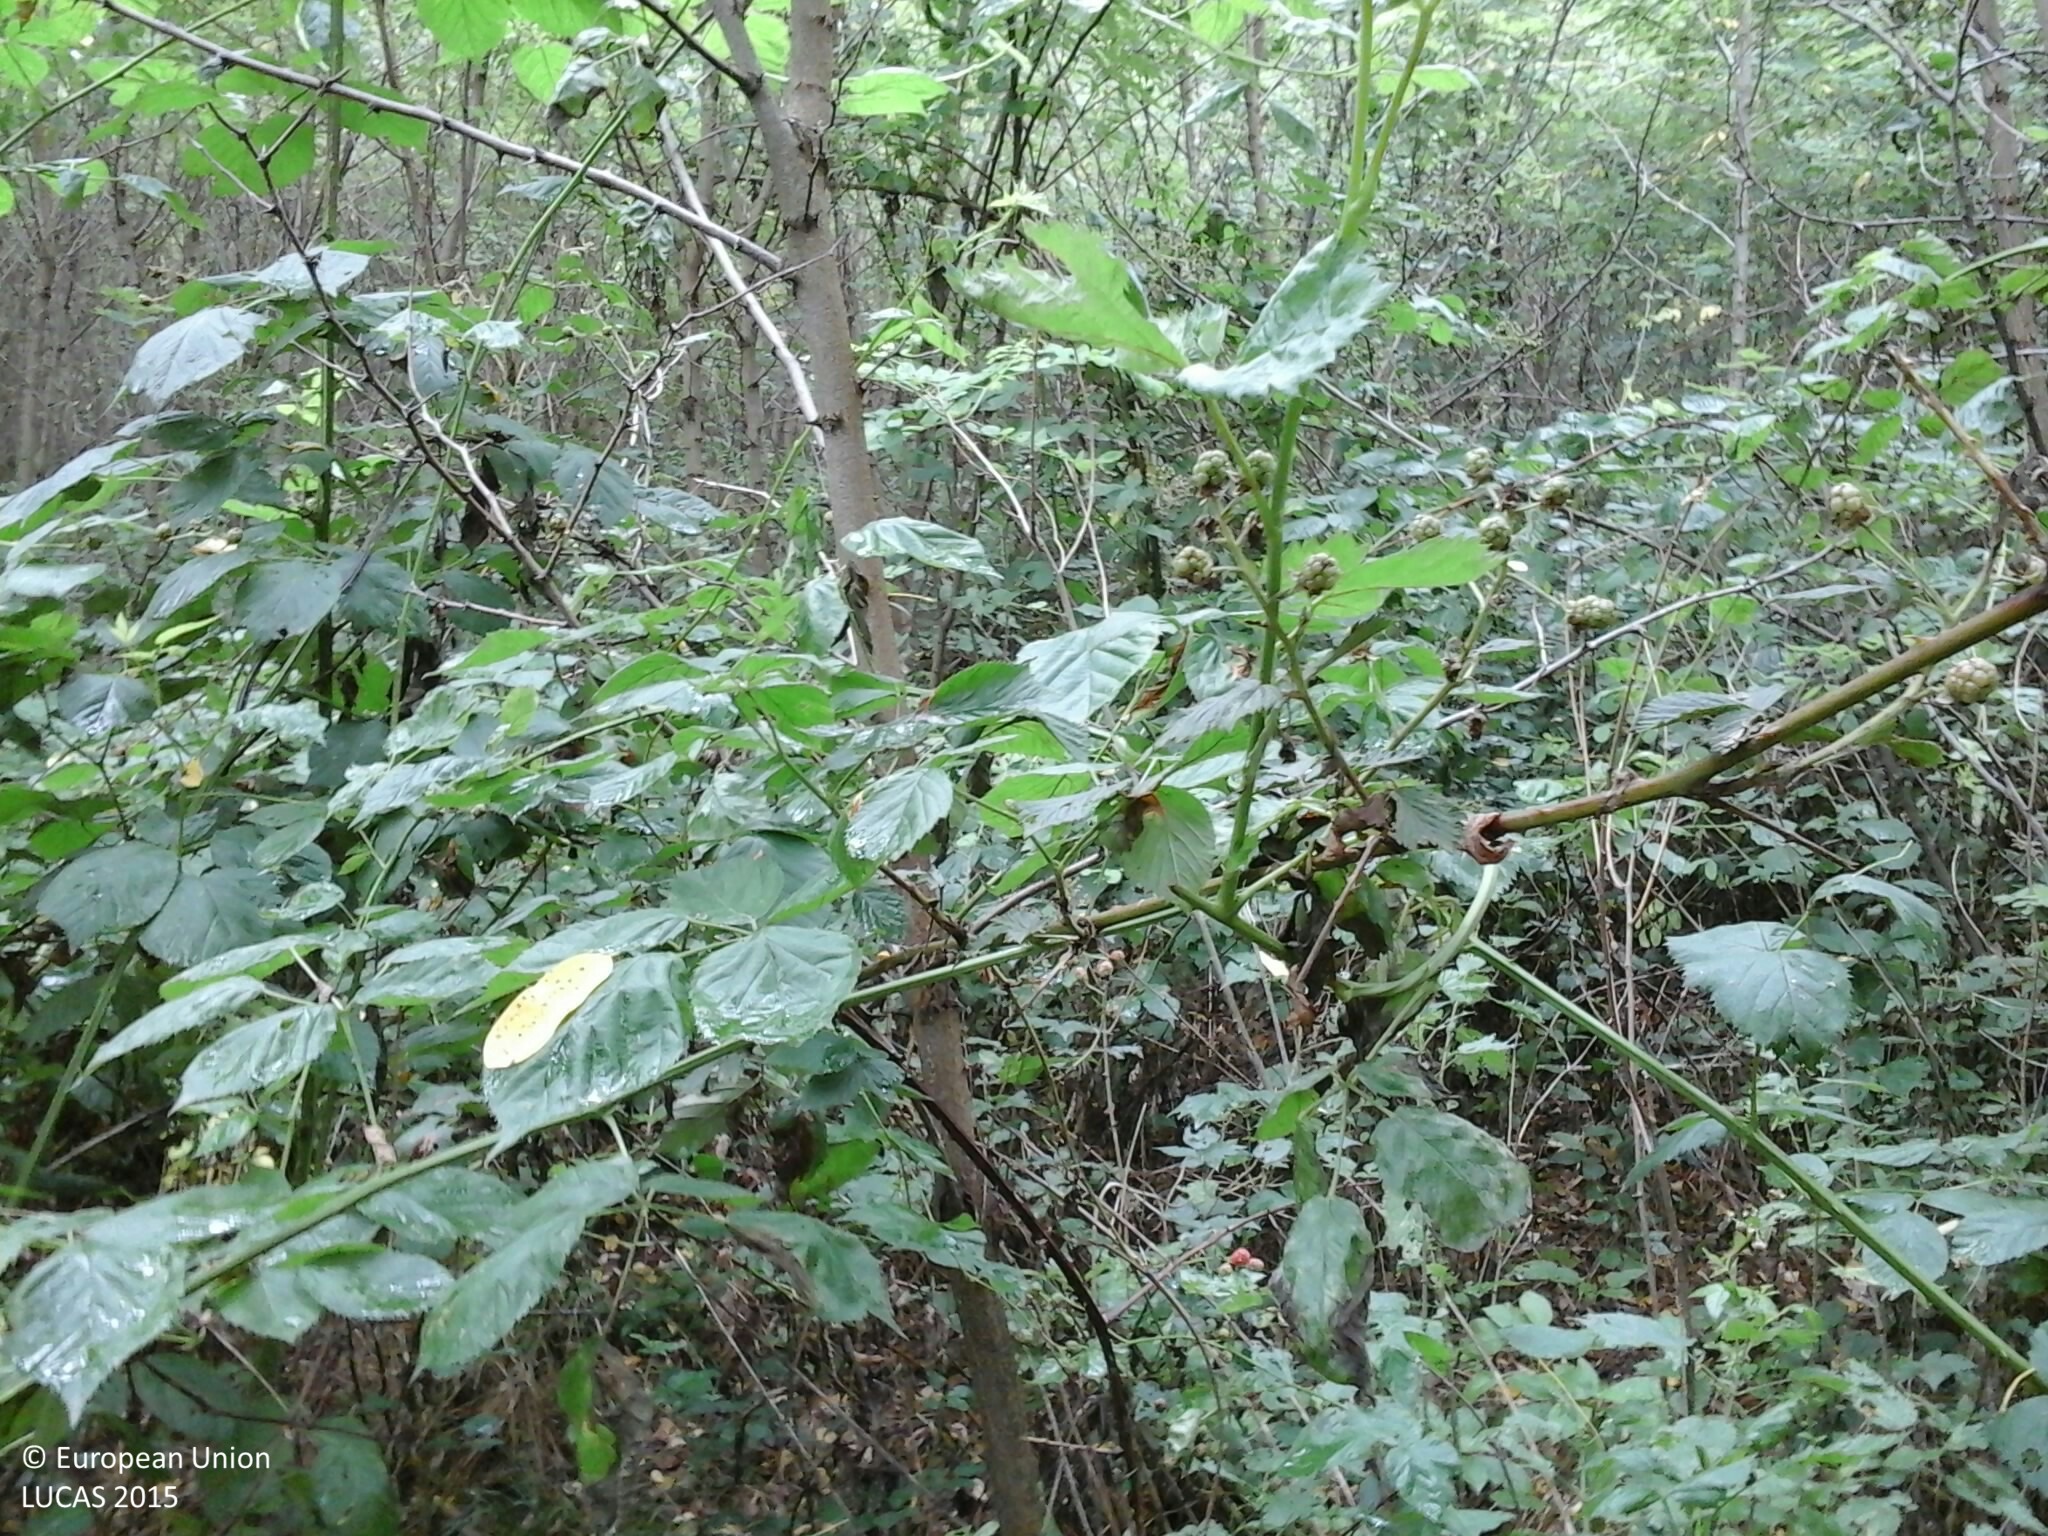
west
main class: Woodland
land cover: Broadleaved woodland
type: exotic forest
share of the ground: > 75 %
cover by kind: broadleaved forest trees 70 %, shrubs 20 %, herbaceous plants 10 %
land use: Forestry
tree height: < 5 m
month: July
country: HU
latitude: 46.8324
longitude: 16.6231
